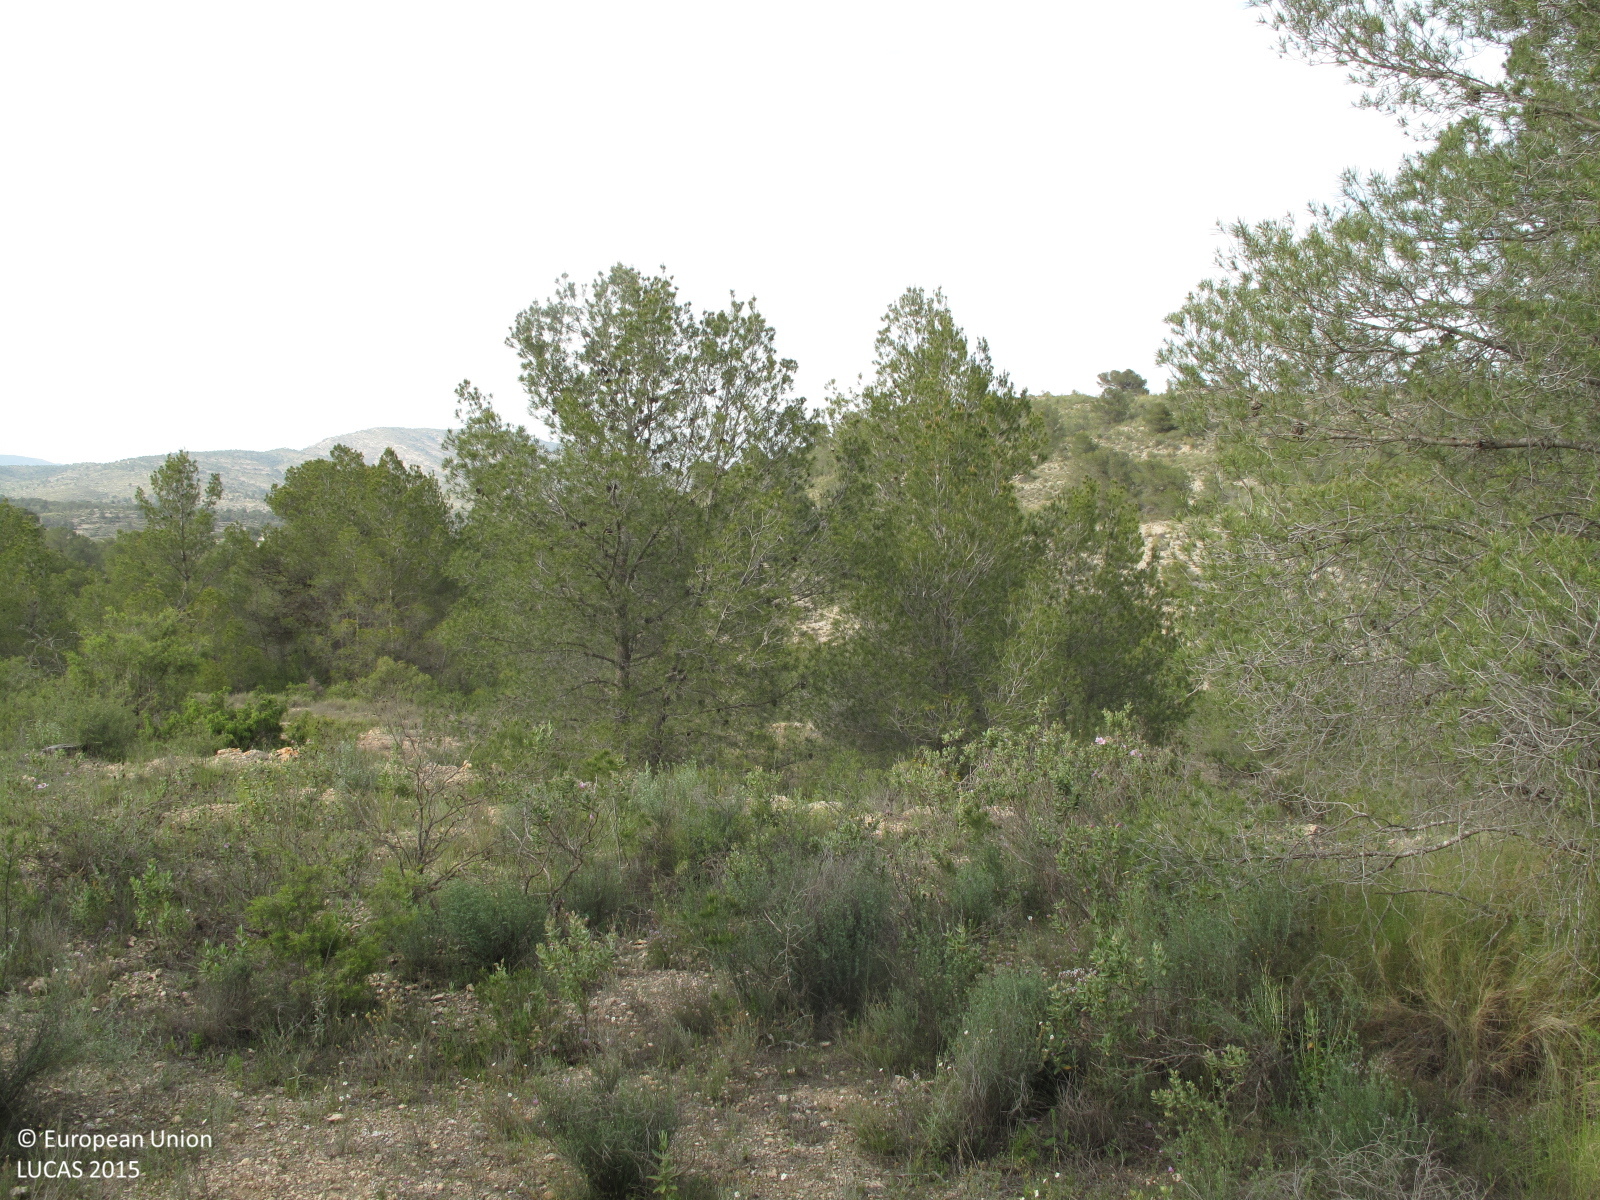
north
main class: Woodland
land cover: Pine dominated coniferous woodland
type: coniferous forest of the mediterranean region
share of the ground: 50 - 75 %
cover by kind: coniferous forest trees 50 %, consolidated bare surface 30 %, shrubs 10 %, herbaceous plants 10 %
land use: Semi-natural and natural areas not in use
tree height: > 5 m
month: April
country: ES
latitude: 38.4190
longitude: -0.8802
